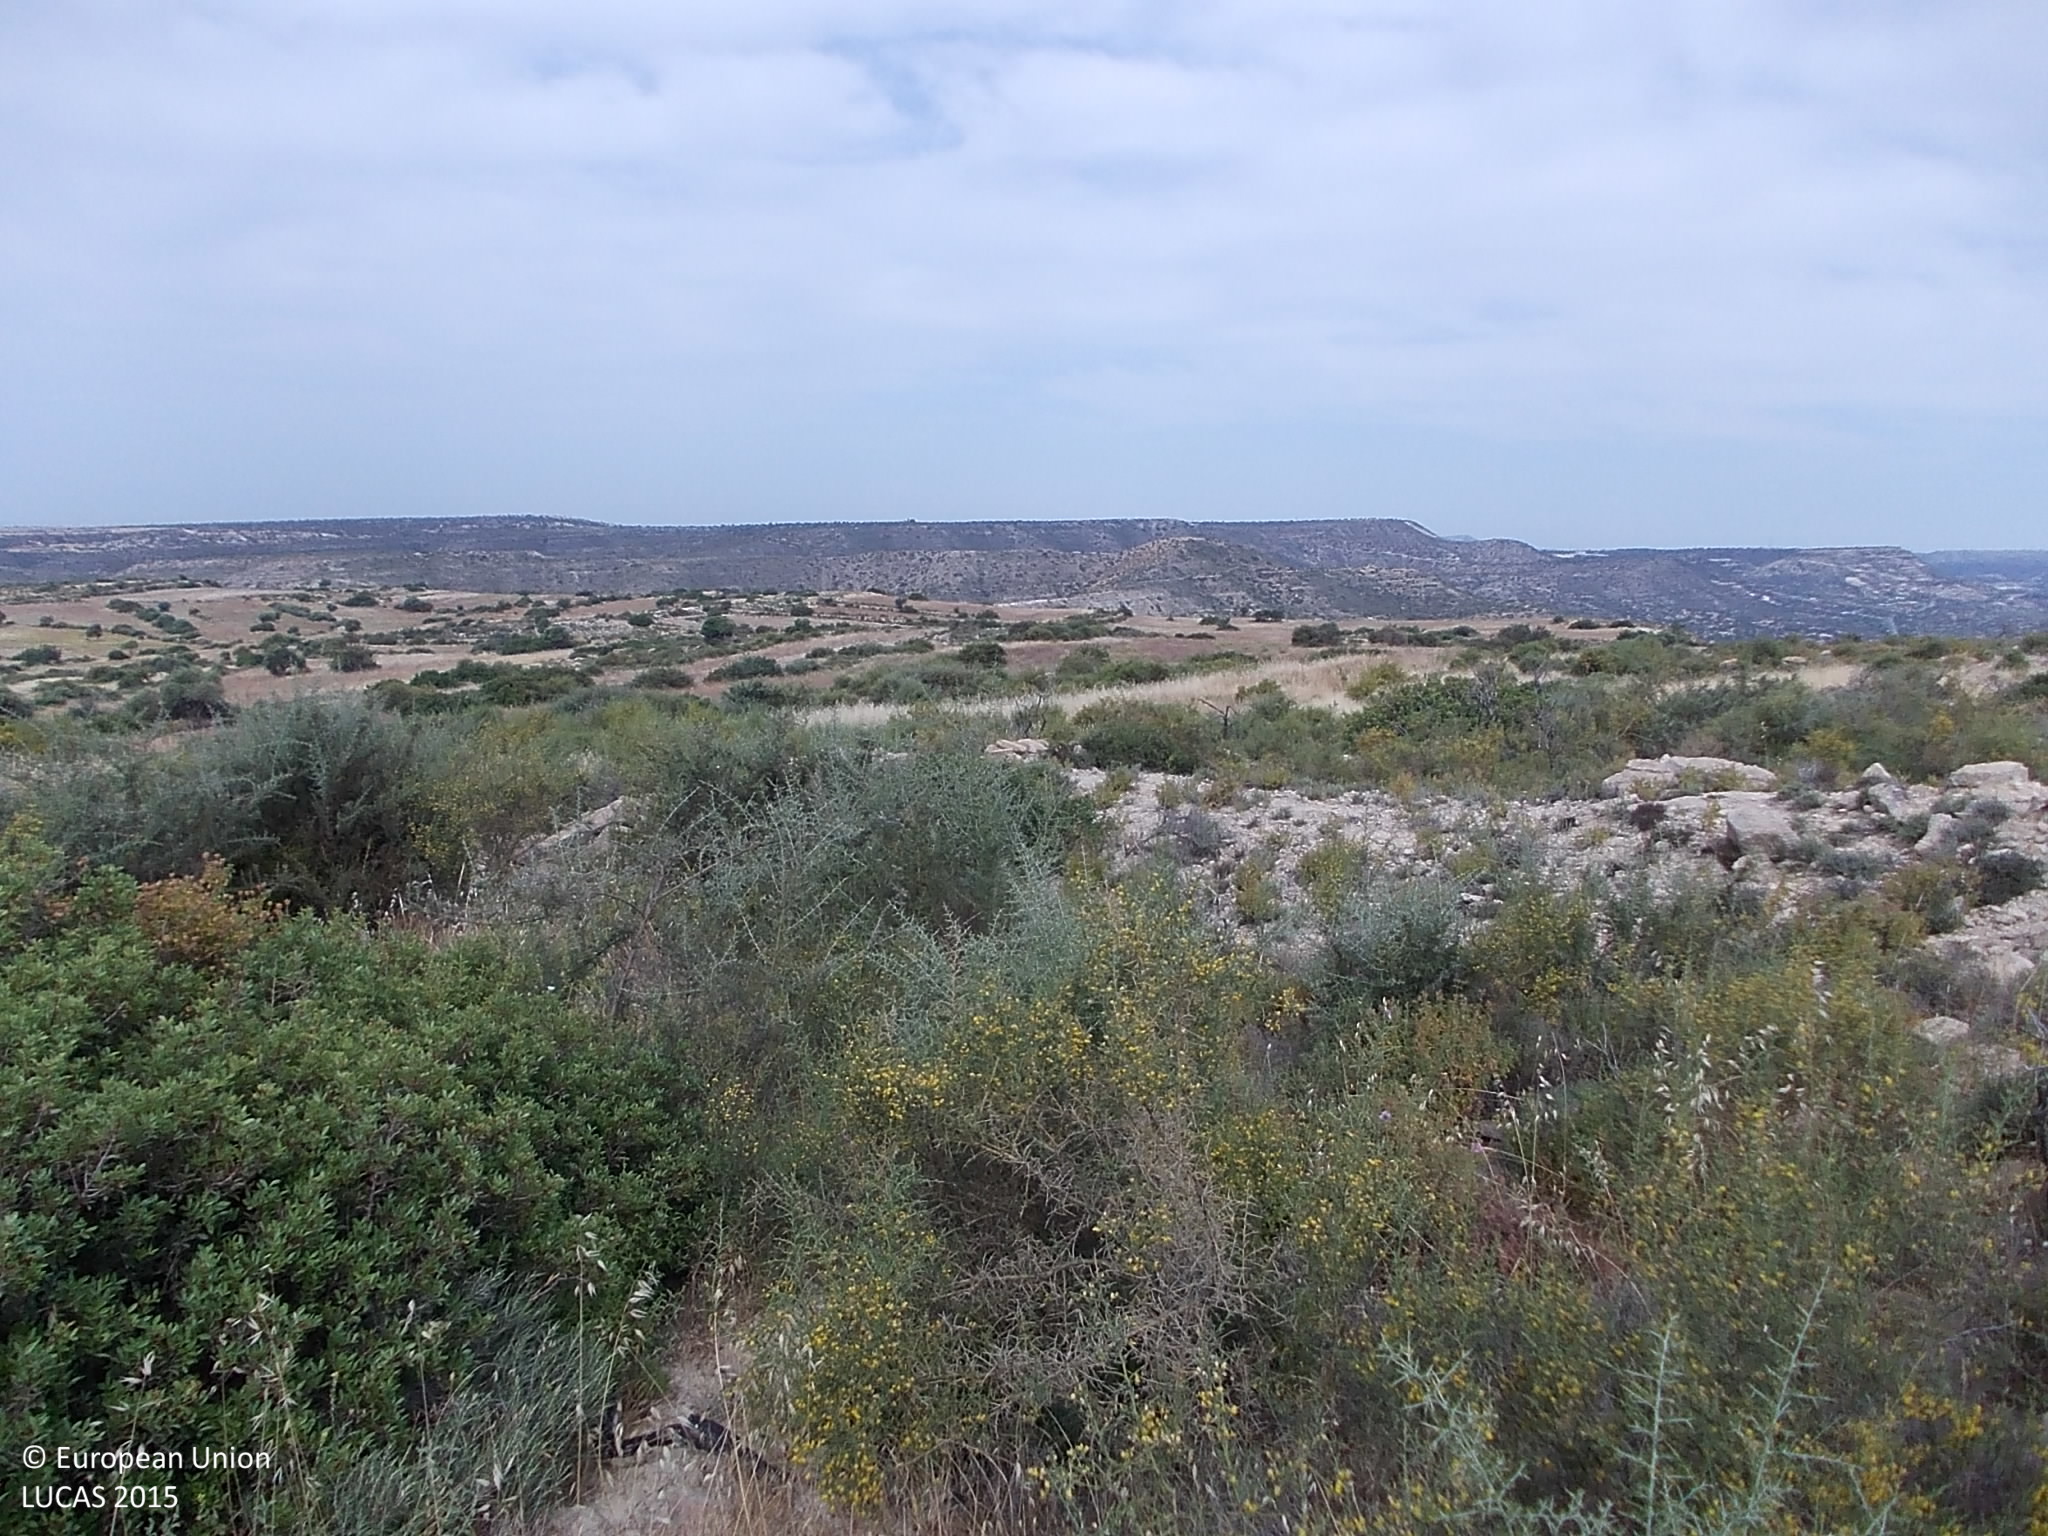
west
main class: Shrubland
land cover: Shrubland without tree cover
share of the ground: 25 - 50 %
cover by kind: shrubs 50 %, consolidated bare surface 20 %, unconsolidated bare surface 20 %, herbaceous plants 10 %
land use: Semi-natural and natural areas not in use
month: May
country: CY
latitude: 34.7370
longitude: 33.0029
